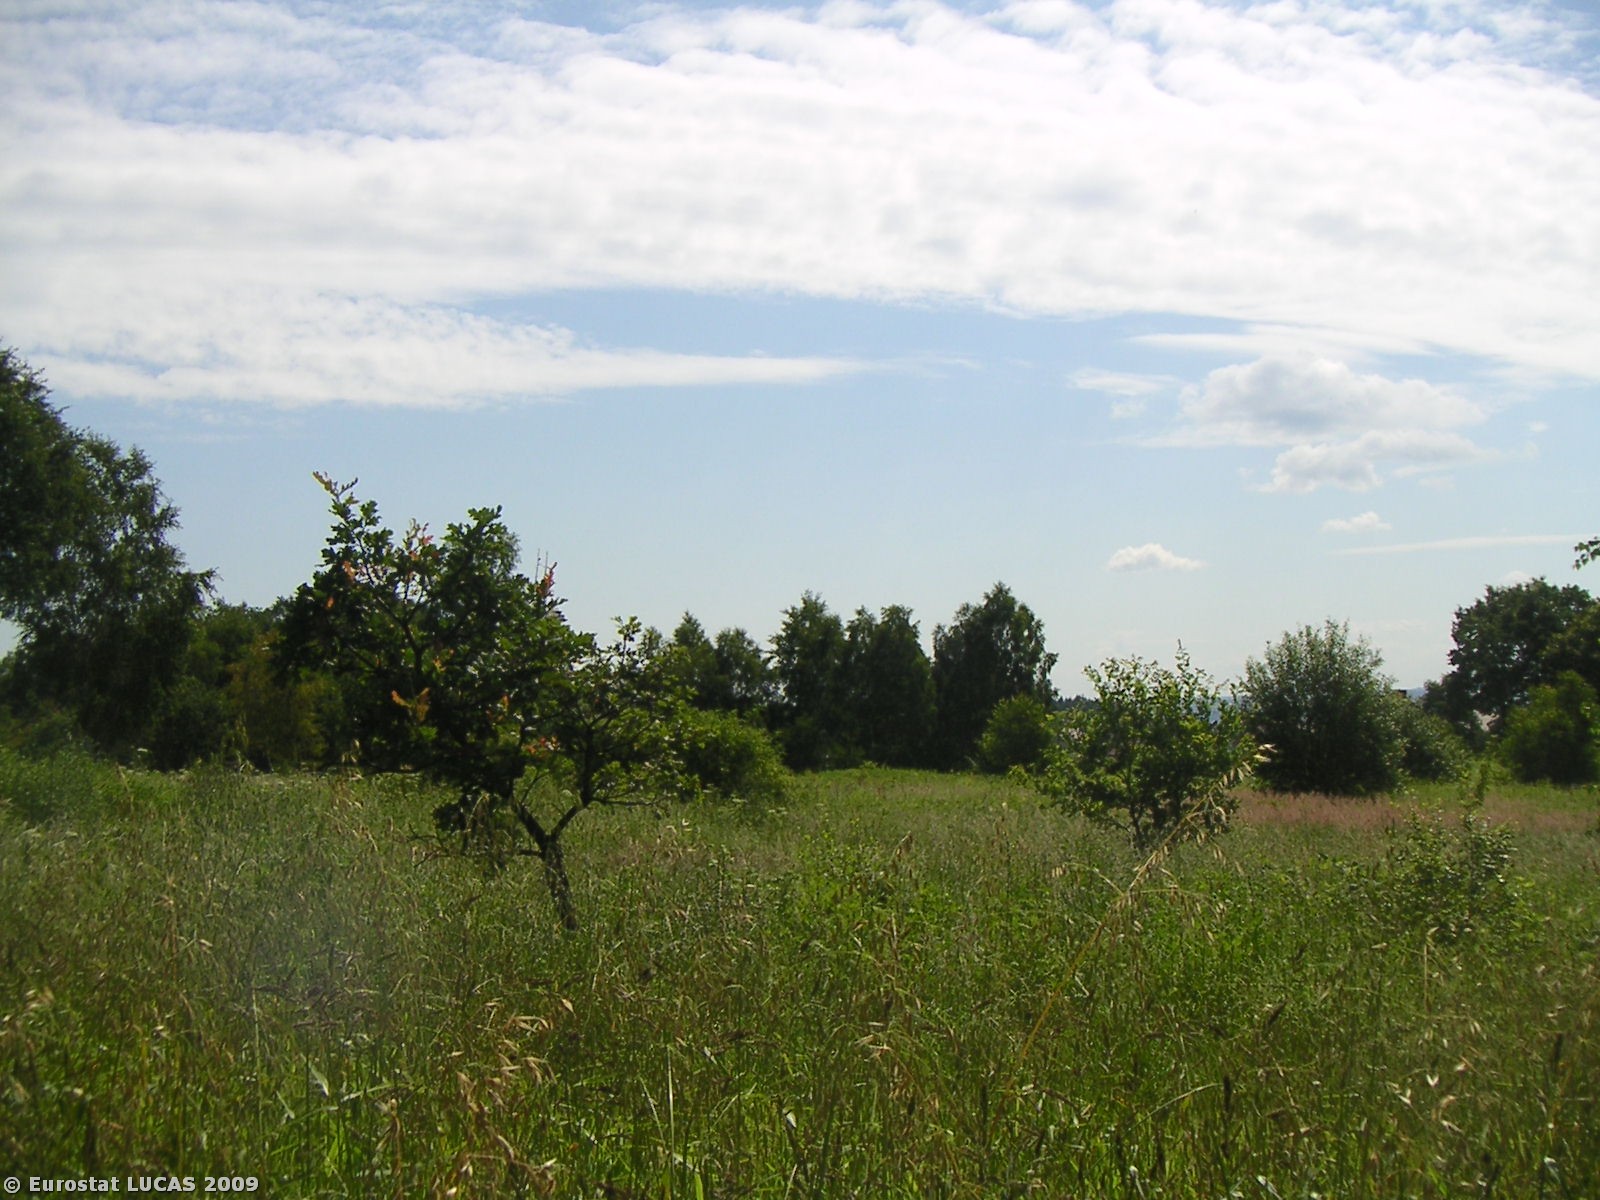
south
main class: Cropland
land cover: Oats
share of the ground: 50 - 75 %
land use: Agriculture (excluding fallow land and kitchen gardens)
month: July
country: PL
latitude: 50.0030
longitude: 19.7260
